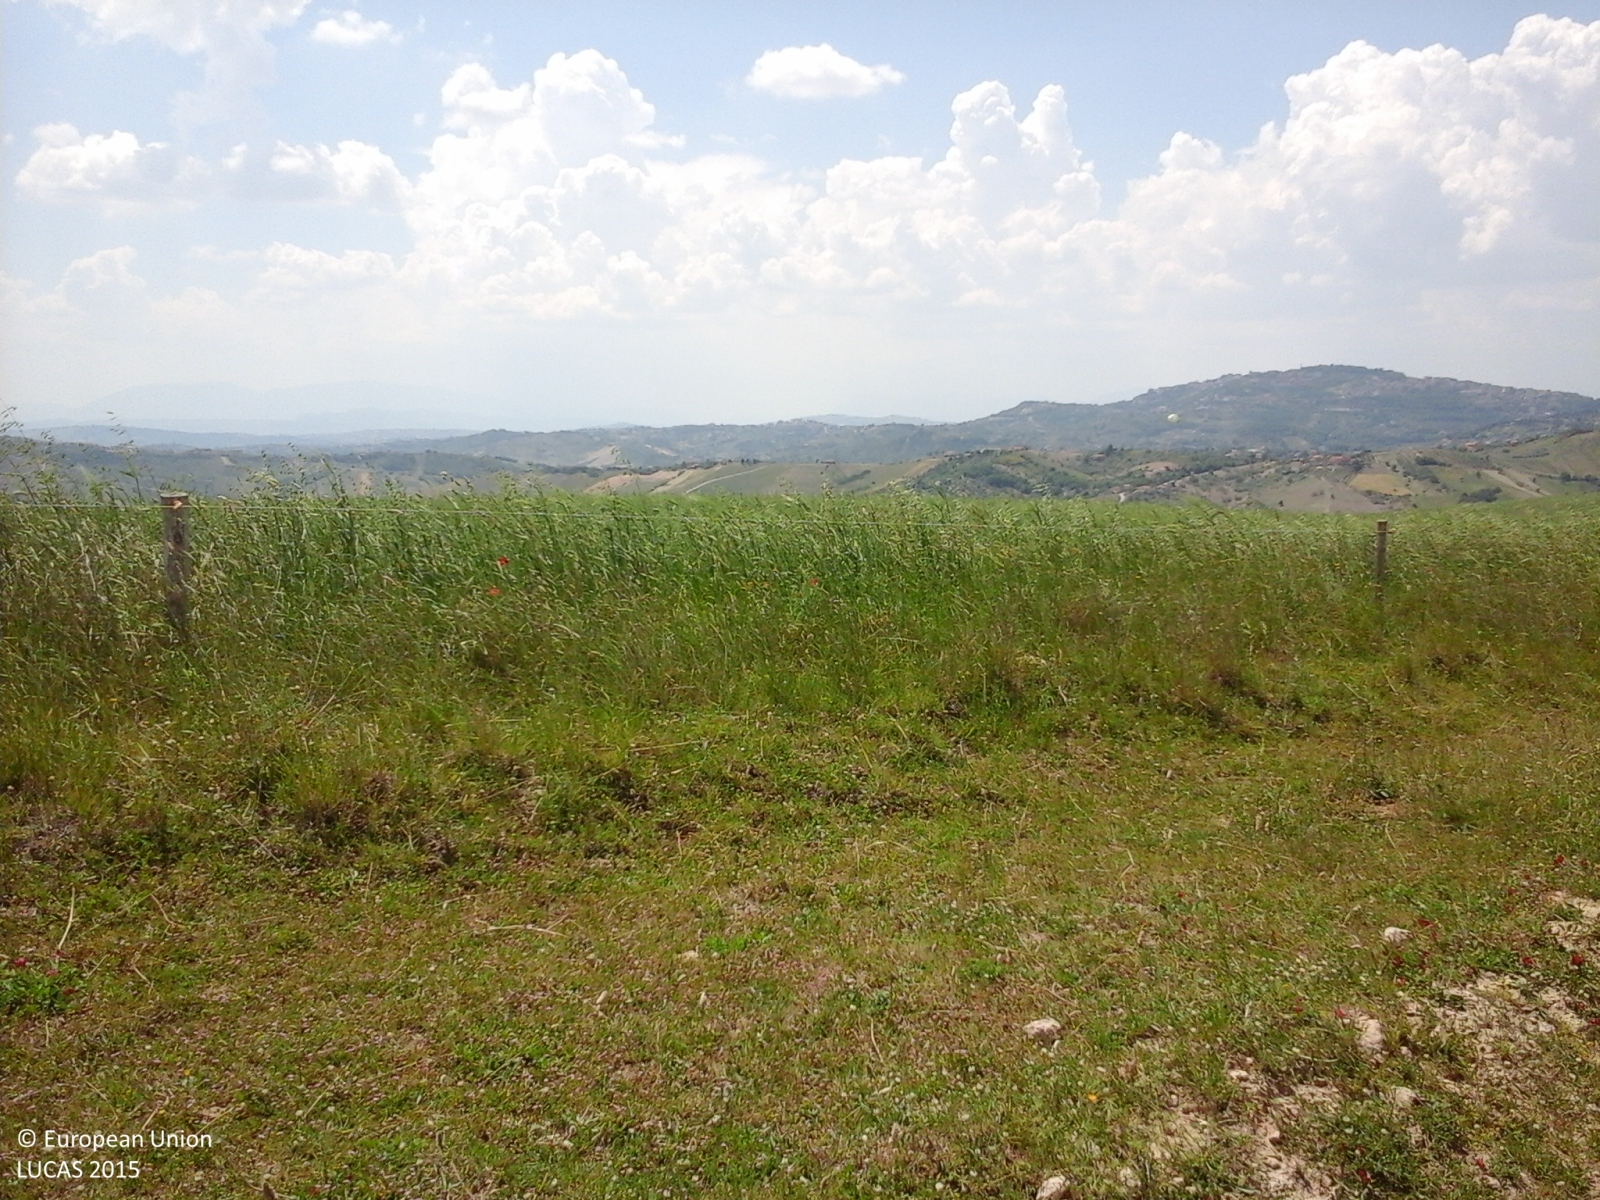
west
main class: Grassland
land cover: Grassland without tree/shrub cover
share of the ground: > 75 %
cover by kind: herbaceous plants 100 %
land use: Agriculture (excluding fallow land and kitchen gardens)
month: June
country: IT
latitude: 41.1463
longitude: 15.1641
